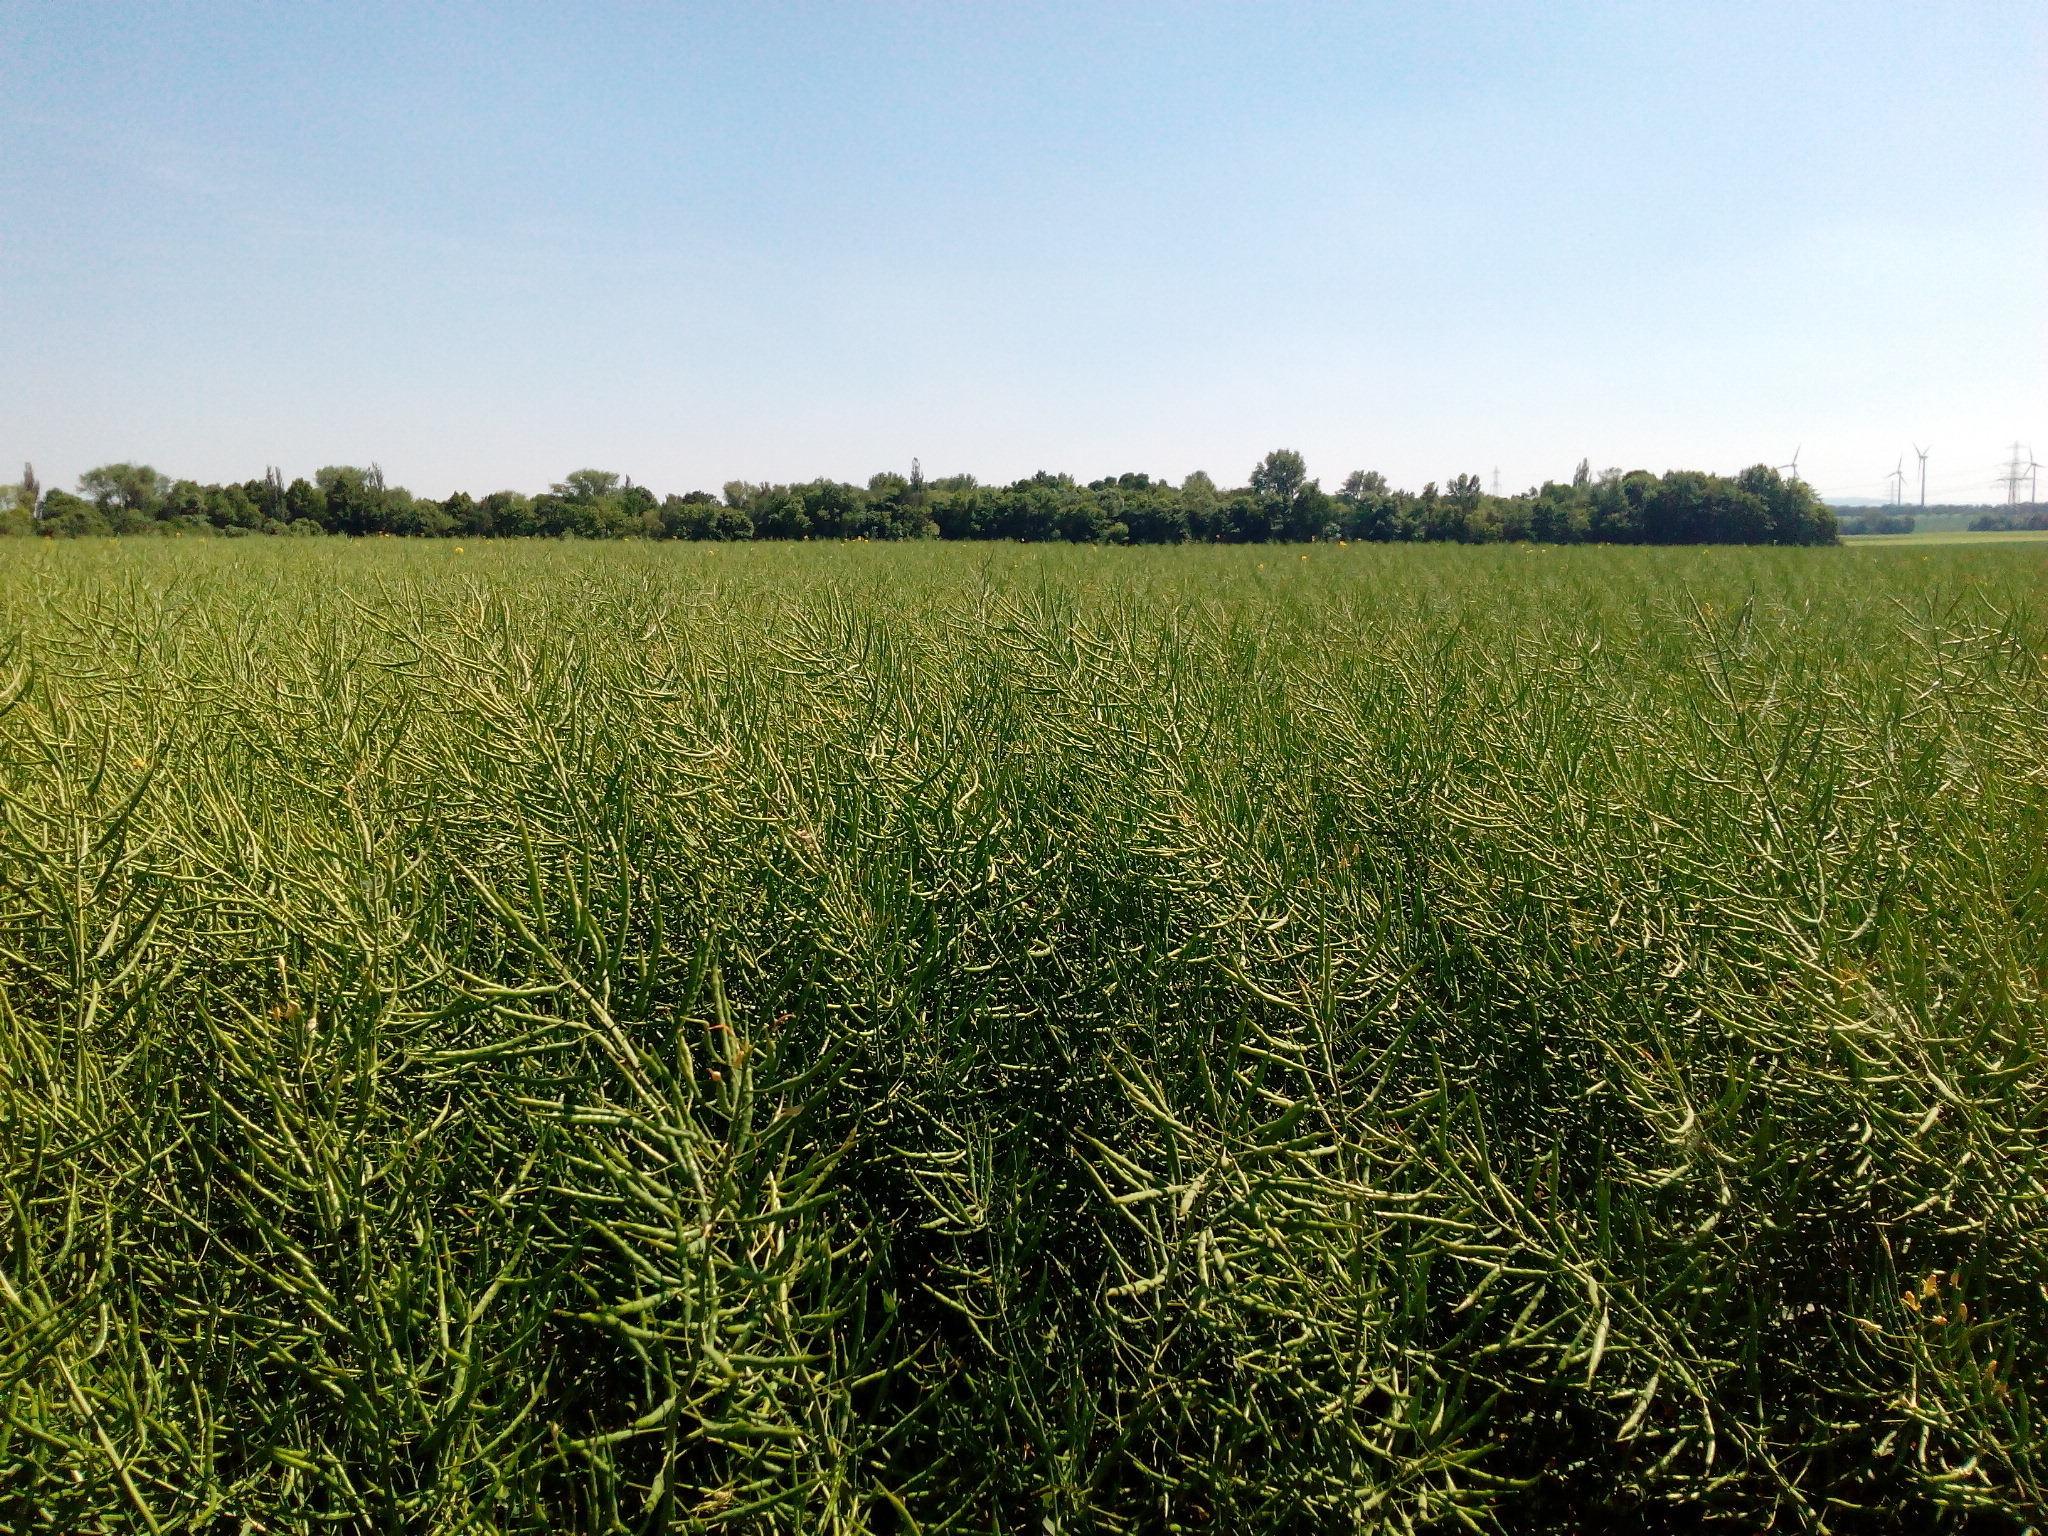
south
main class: Cropland
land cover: Rape and turnip rape
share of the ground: > 75 %
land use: Agriculture (excluding fallow land and kitchen gardens)
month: June
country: DE
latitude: 52.2876
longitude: 9.9267
